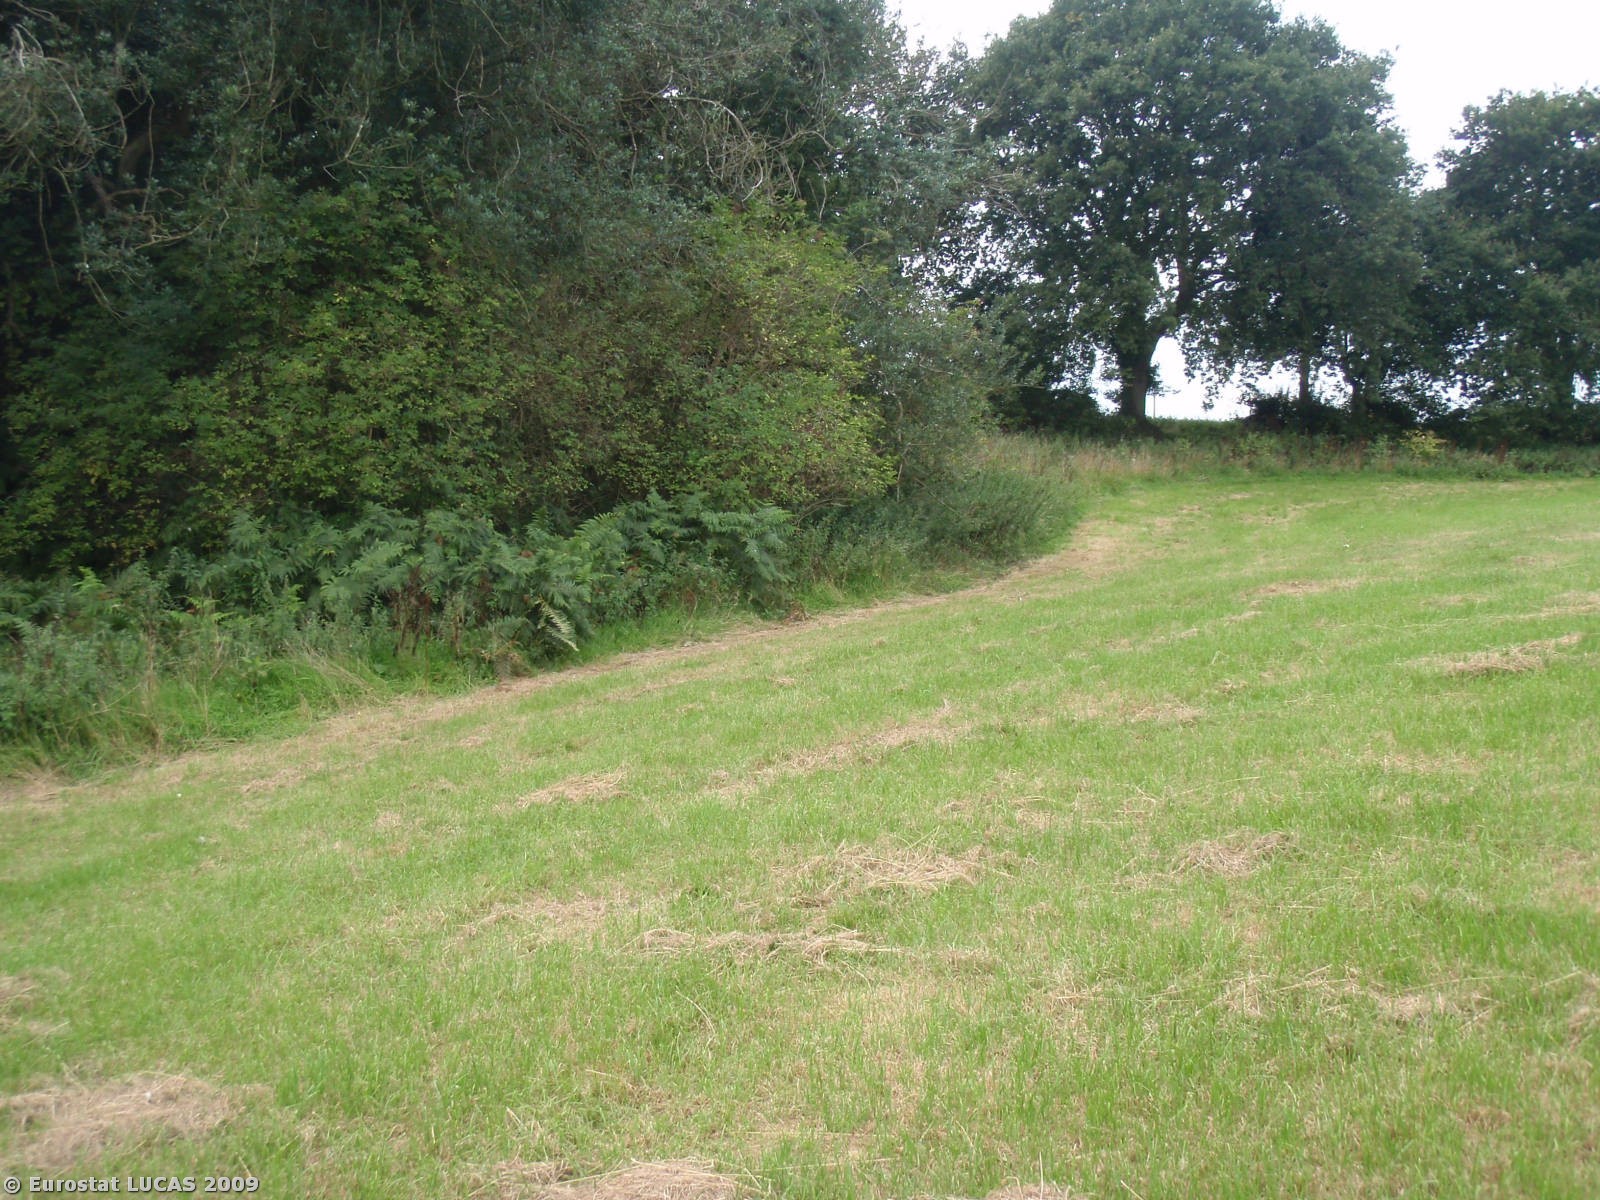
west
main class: Grassland
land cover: Grassland without tree/shrub cover
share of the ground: > 75 %
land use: Agriculture (excluding fallow land and kitchen gardens)
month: August
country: GB
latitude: 50.7590
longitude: -2.0664
